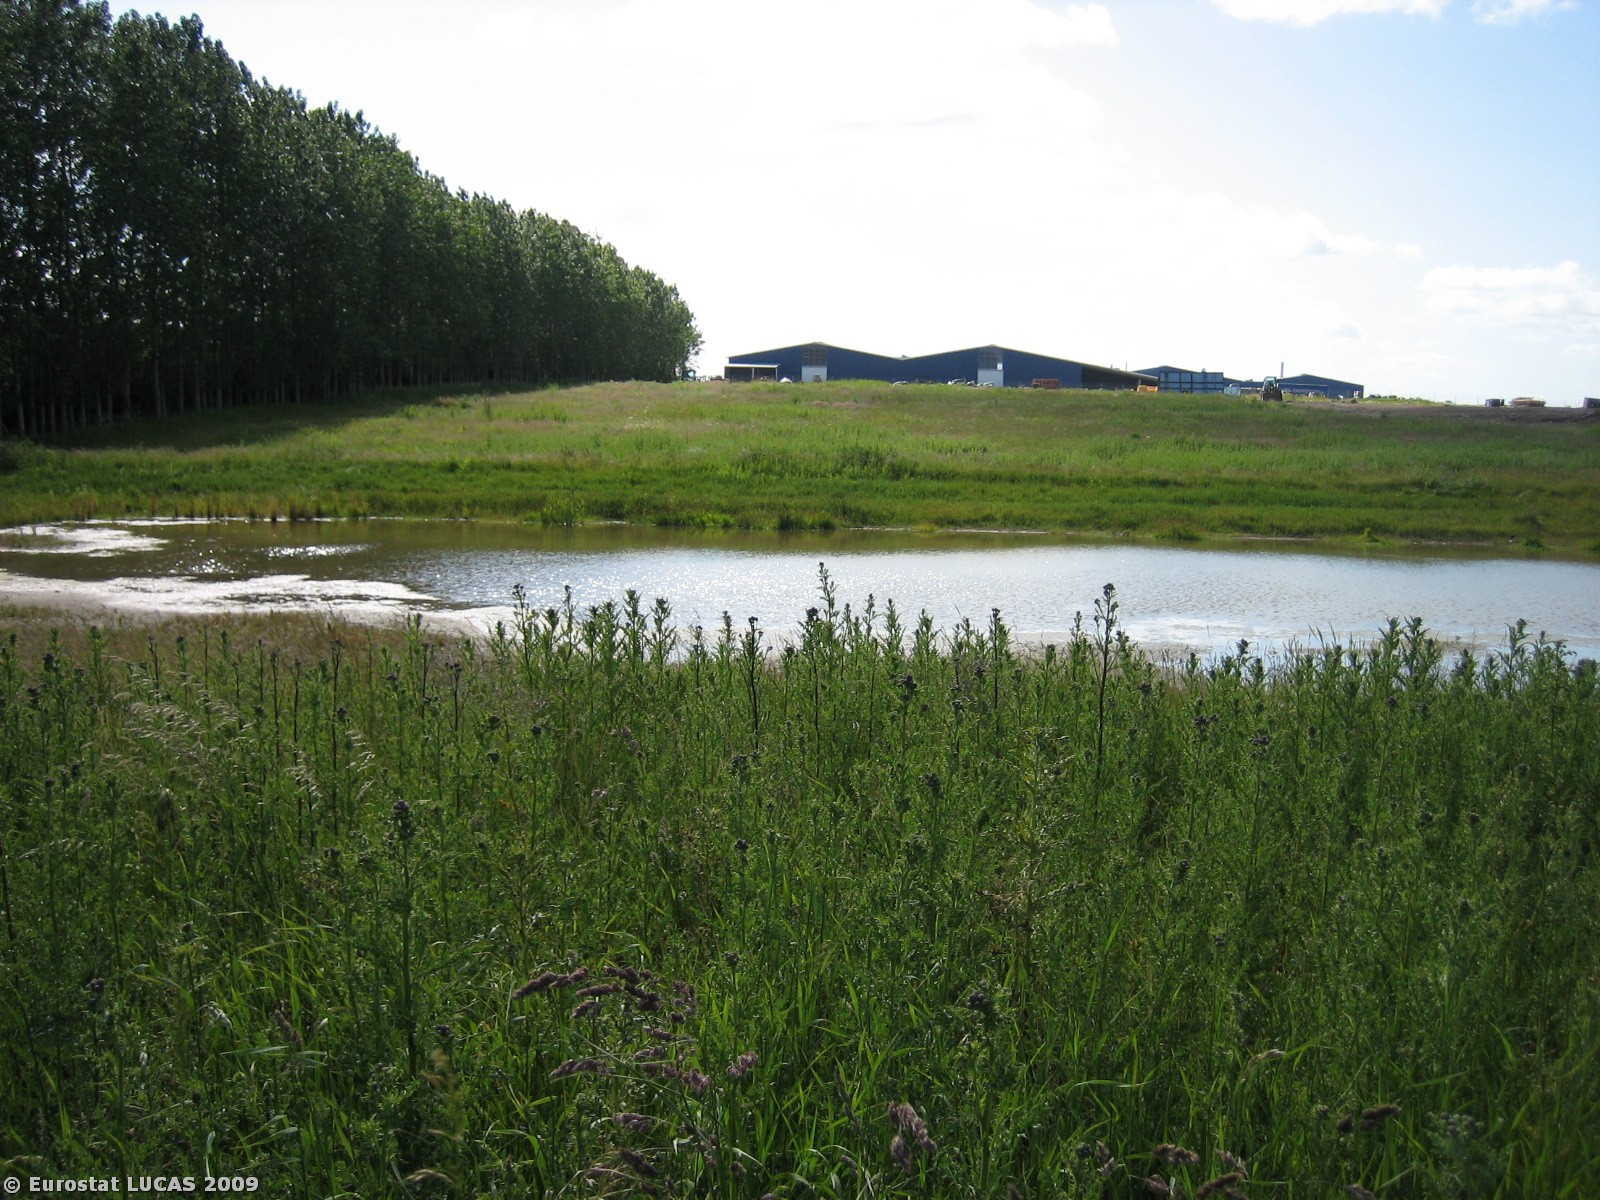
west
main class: Grassland
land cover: Grassland without tree/shrub cover
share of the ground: > 75 %
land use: Unused
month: June
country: DK
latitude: 55.7560
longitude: 9.6976
